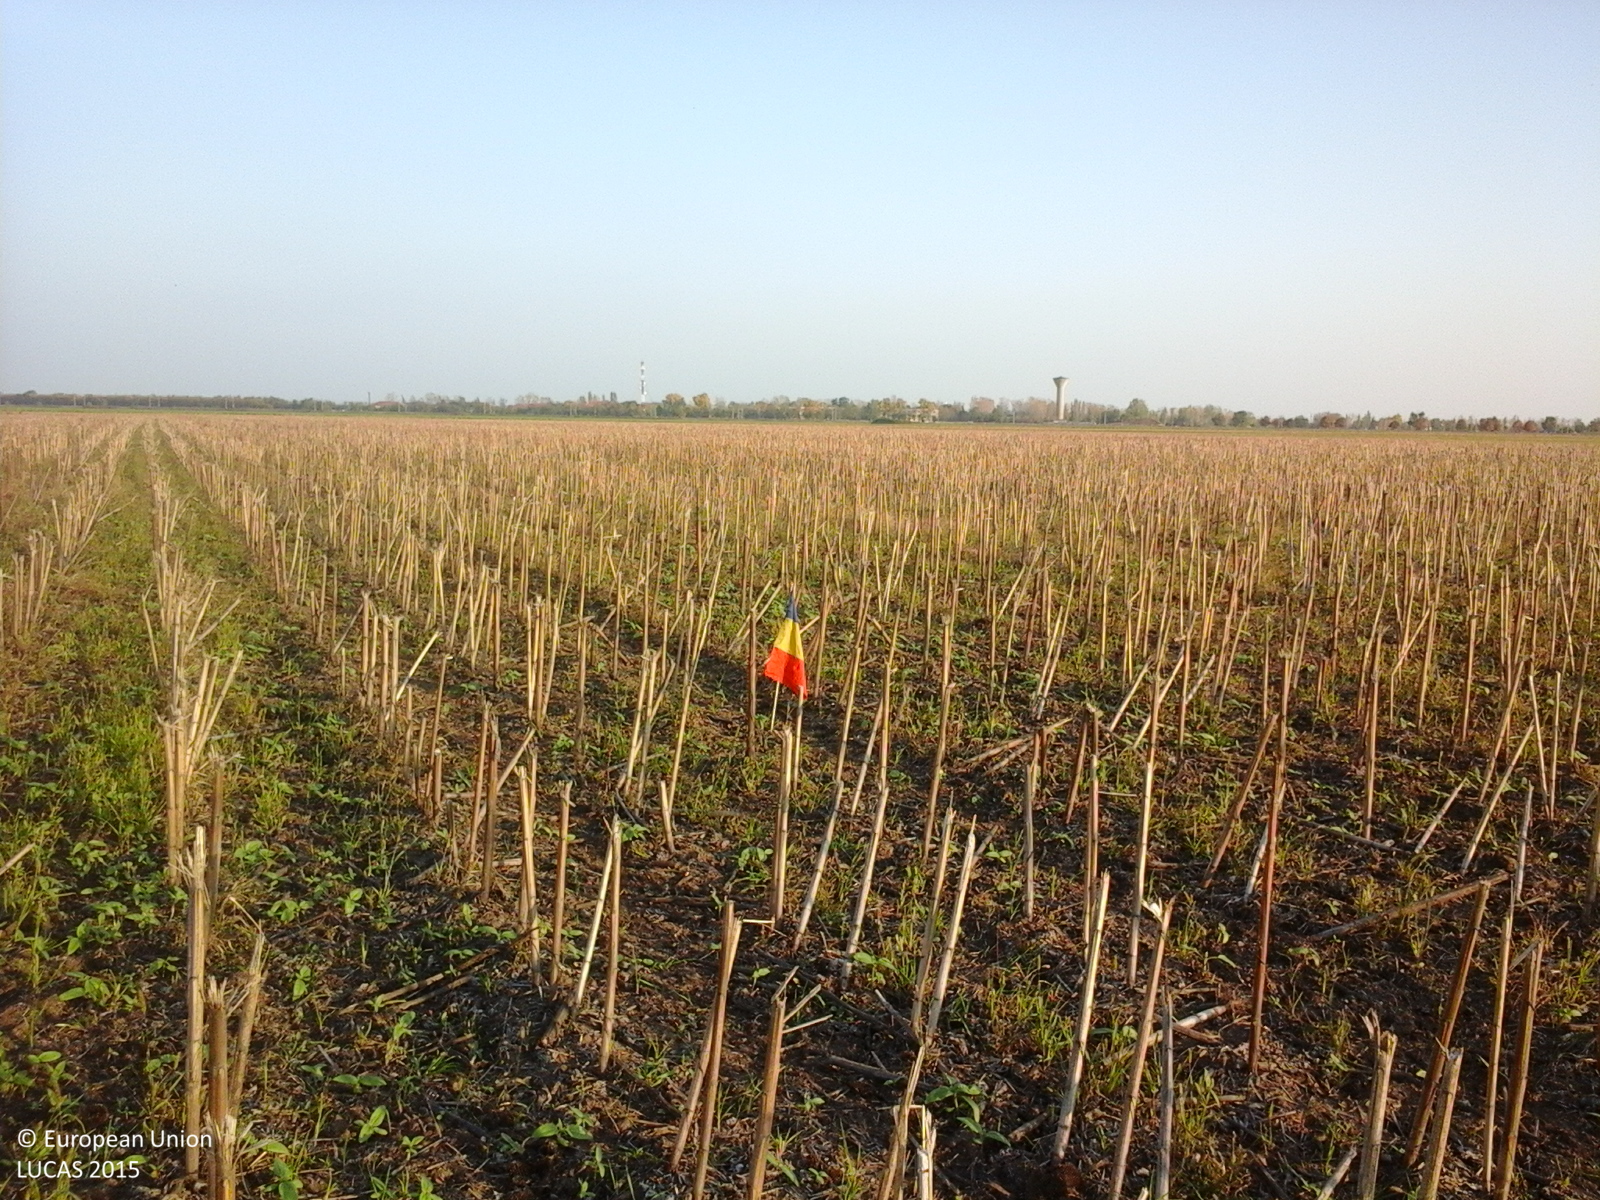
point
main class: Cropland
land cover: Sunflower
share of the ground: 25 - 50 %
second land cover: Spontaneously vegetated surfaces
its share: 25 - 50 %
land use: Agriculture (excluding fallow land and kitchen gardens)
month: October
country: RO
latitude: 45.2274
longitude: 26.9338
